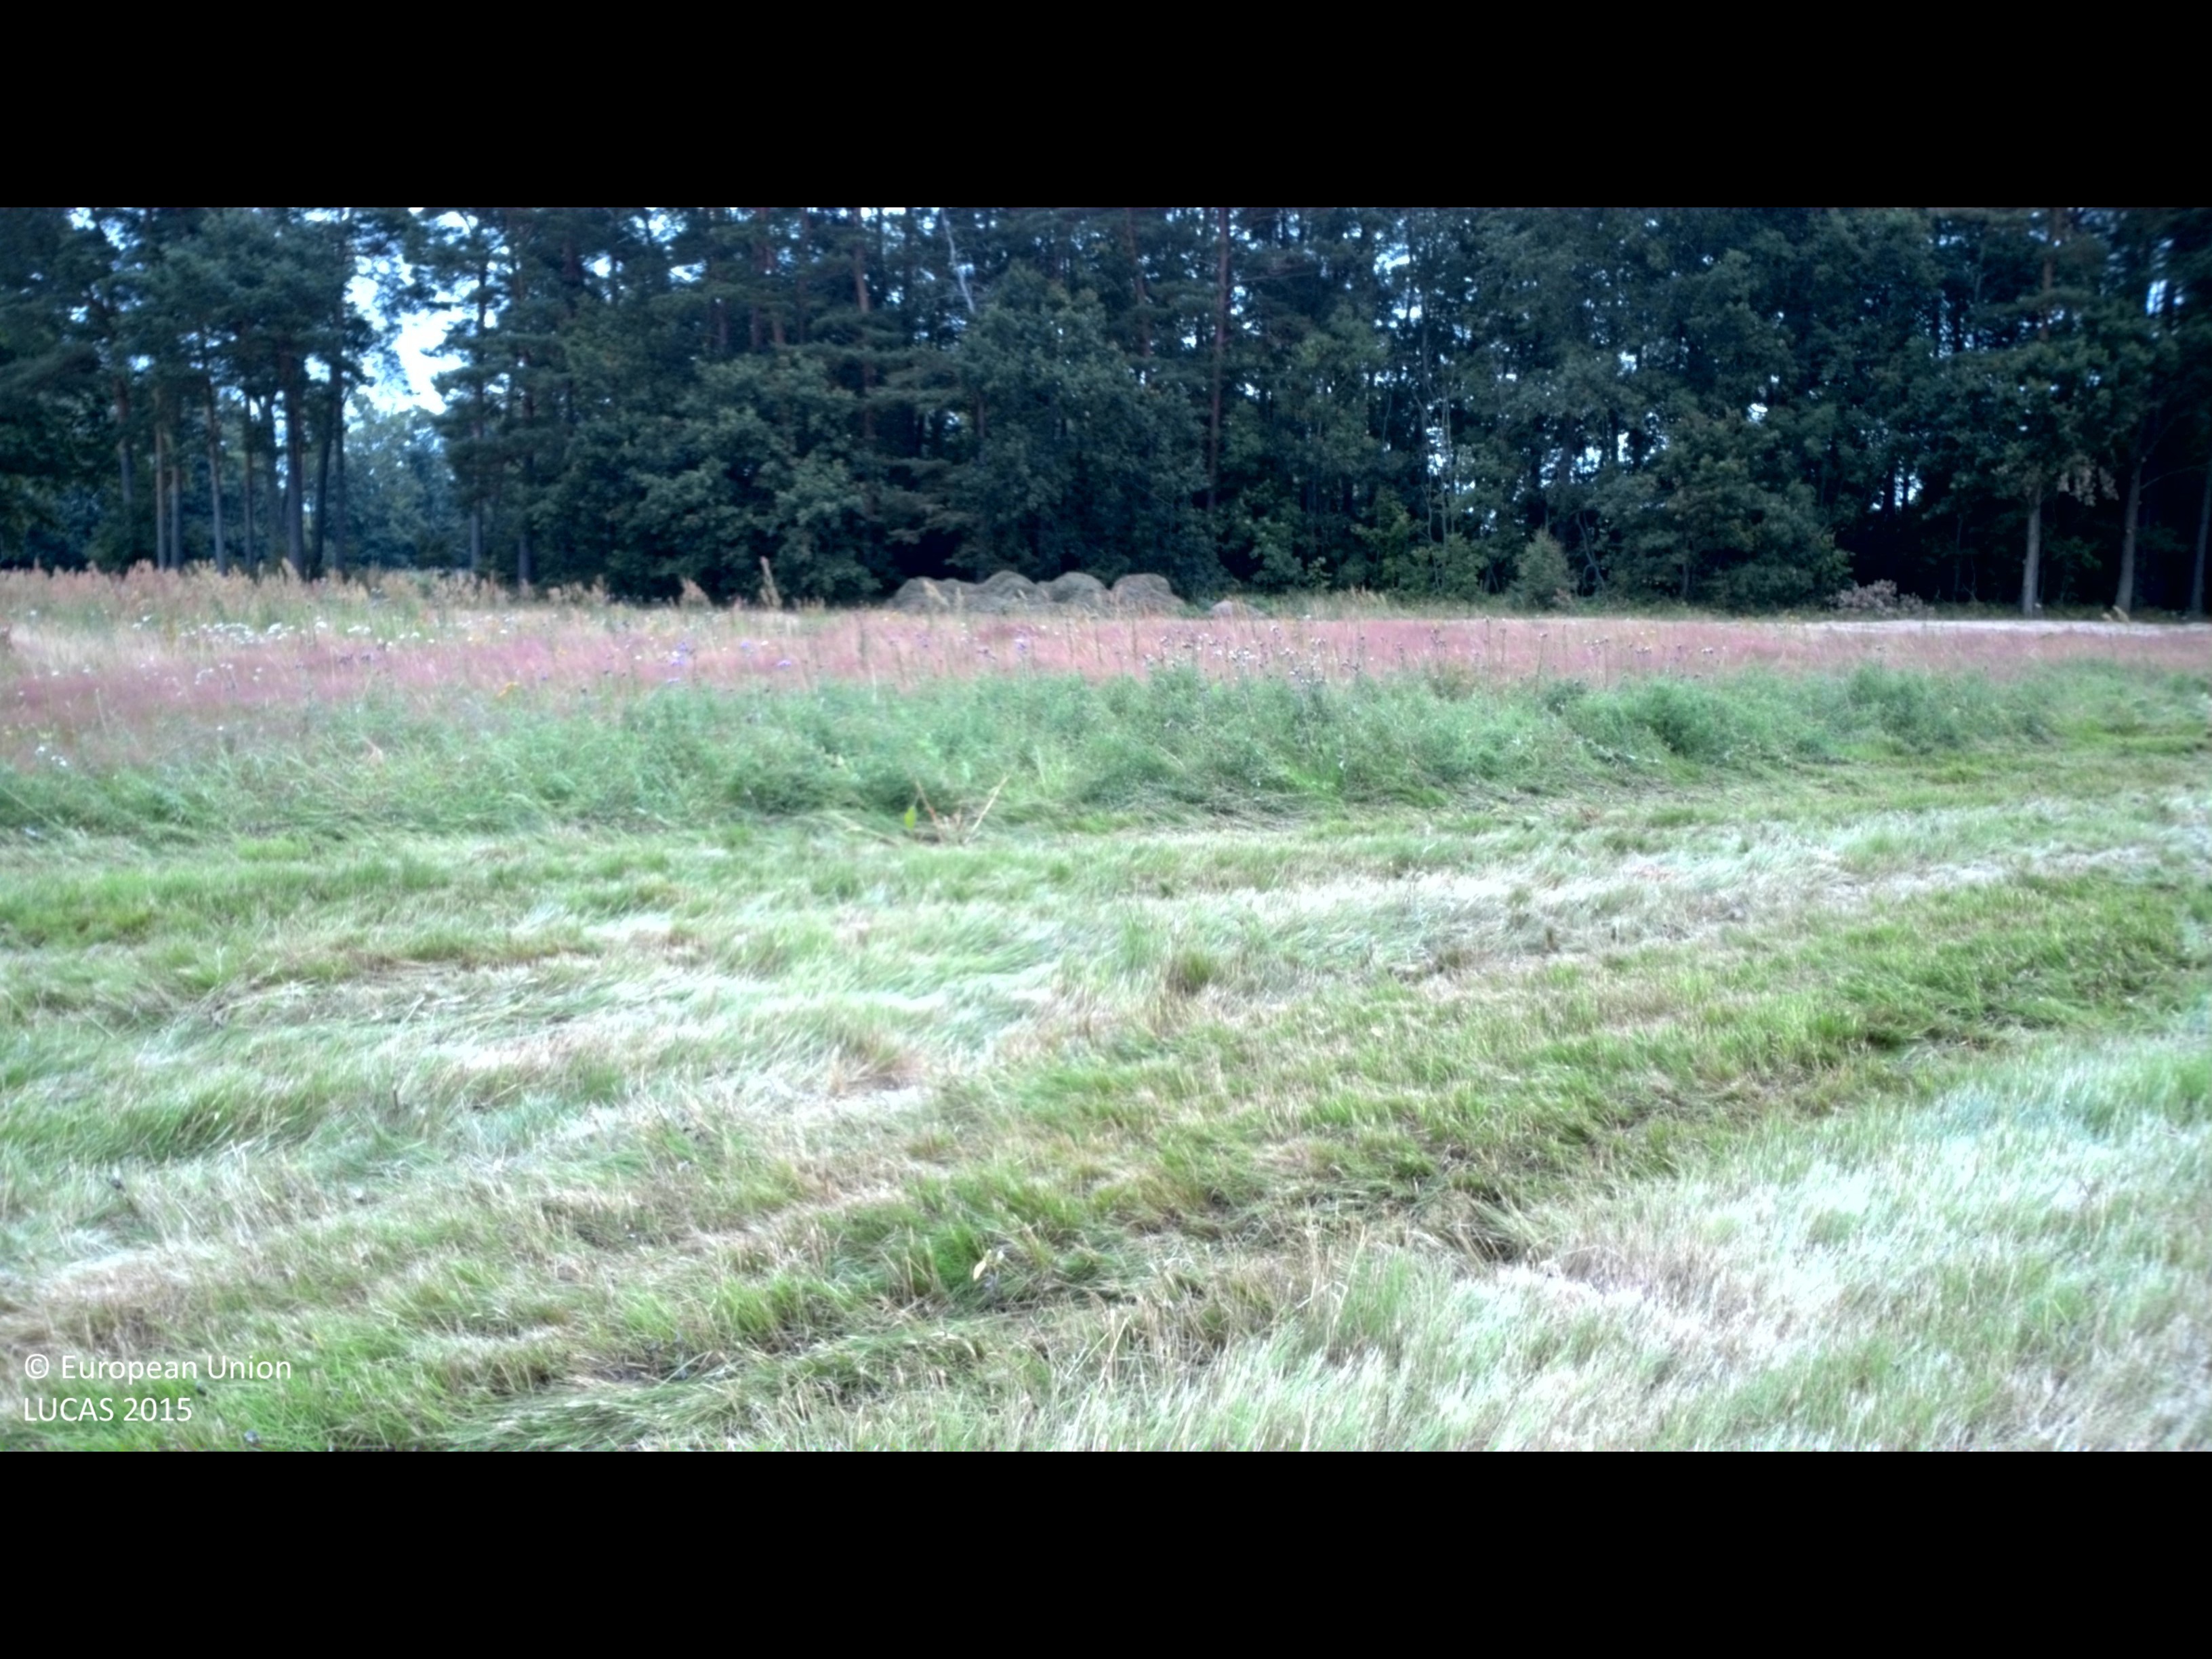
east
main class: Grassland
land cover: Grassland without tree/shrub cover
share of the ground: > 75 %
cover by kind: herbaceous plants 100 %
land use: Sport
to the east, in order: Grassland without tree/shrub cover; Tracks; Ditches and canals; Grassland without tree/shrub cover; Shruby margins; Pine dominated coniferous woodland; Tracks; Broadleaved woodland; Dry stone walls; Grassland without tree/shrub cover; Broadleaved woodland
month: July
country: SE
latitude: 56.7776
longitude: 16.5637
